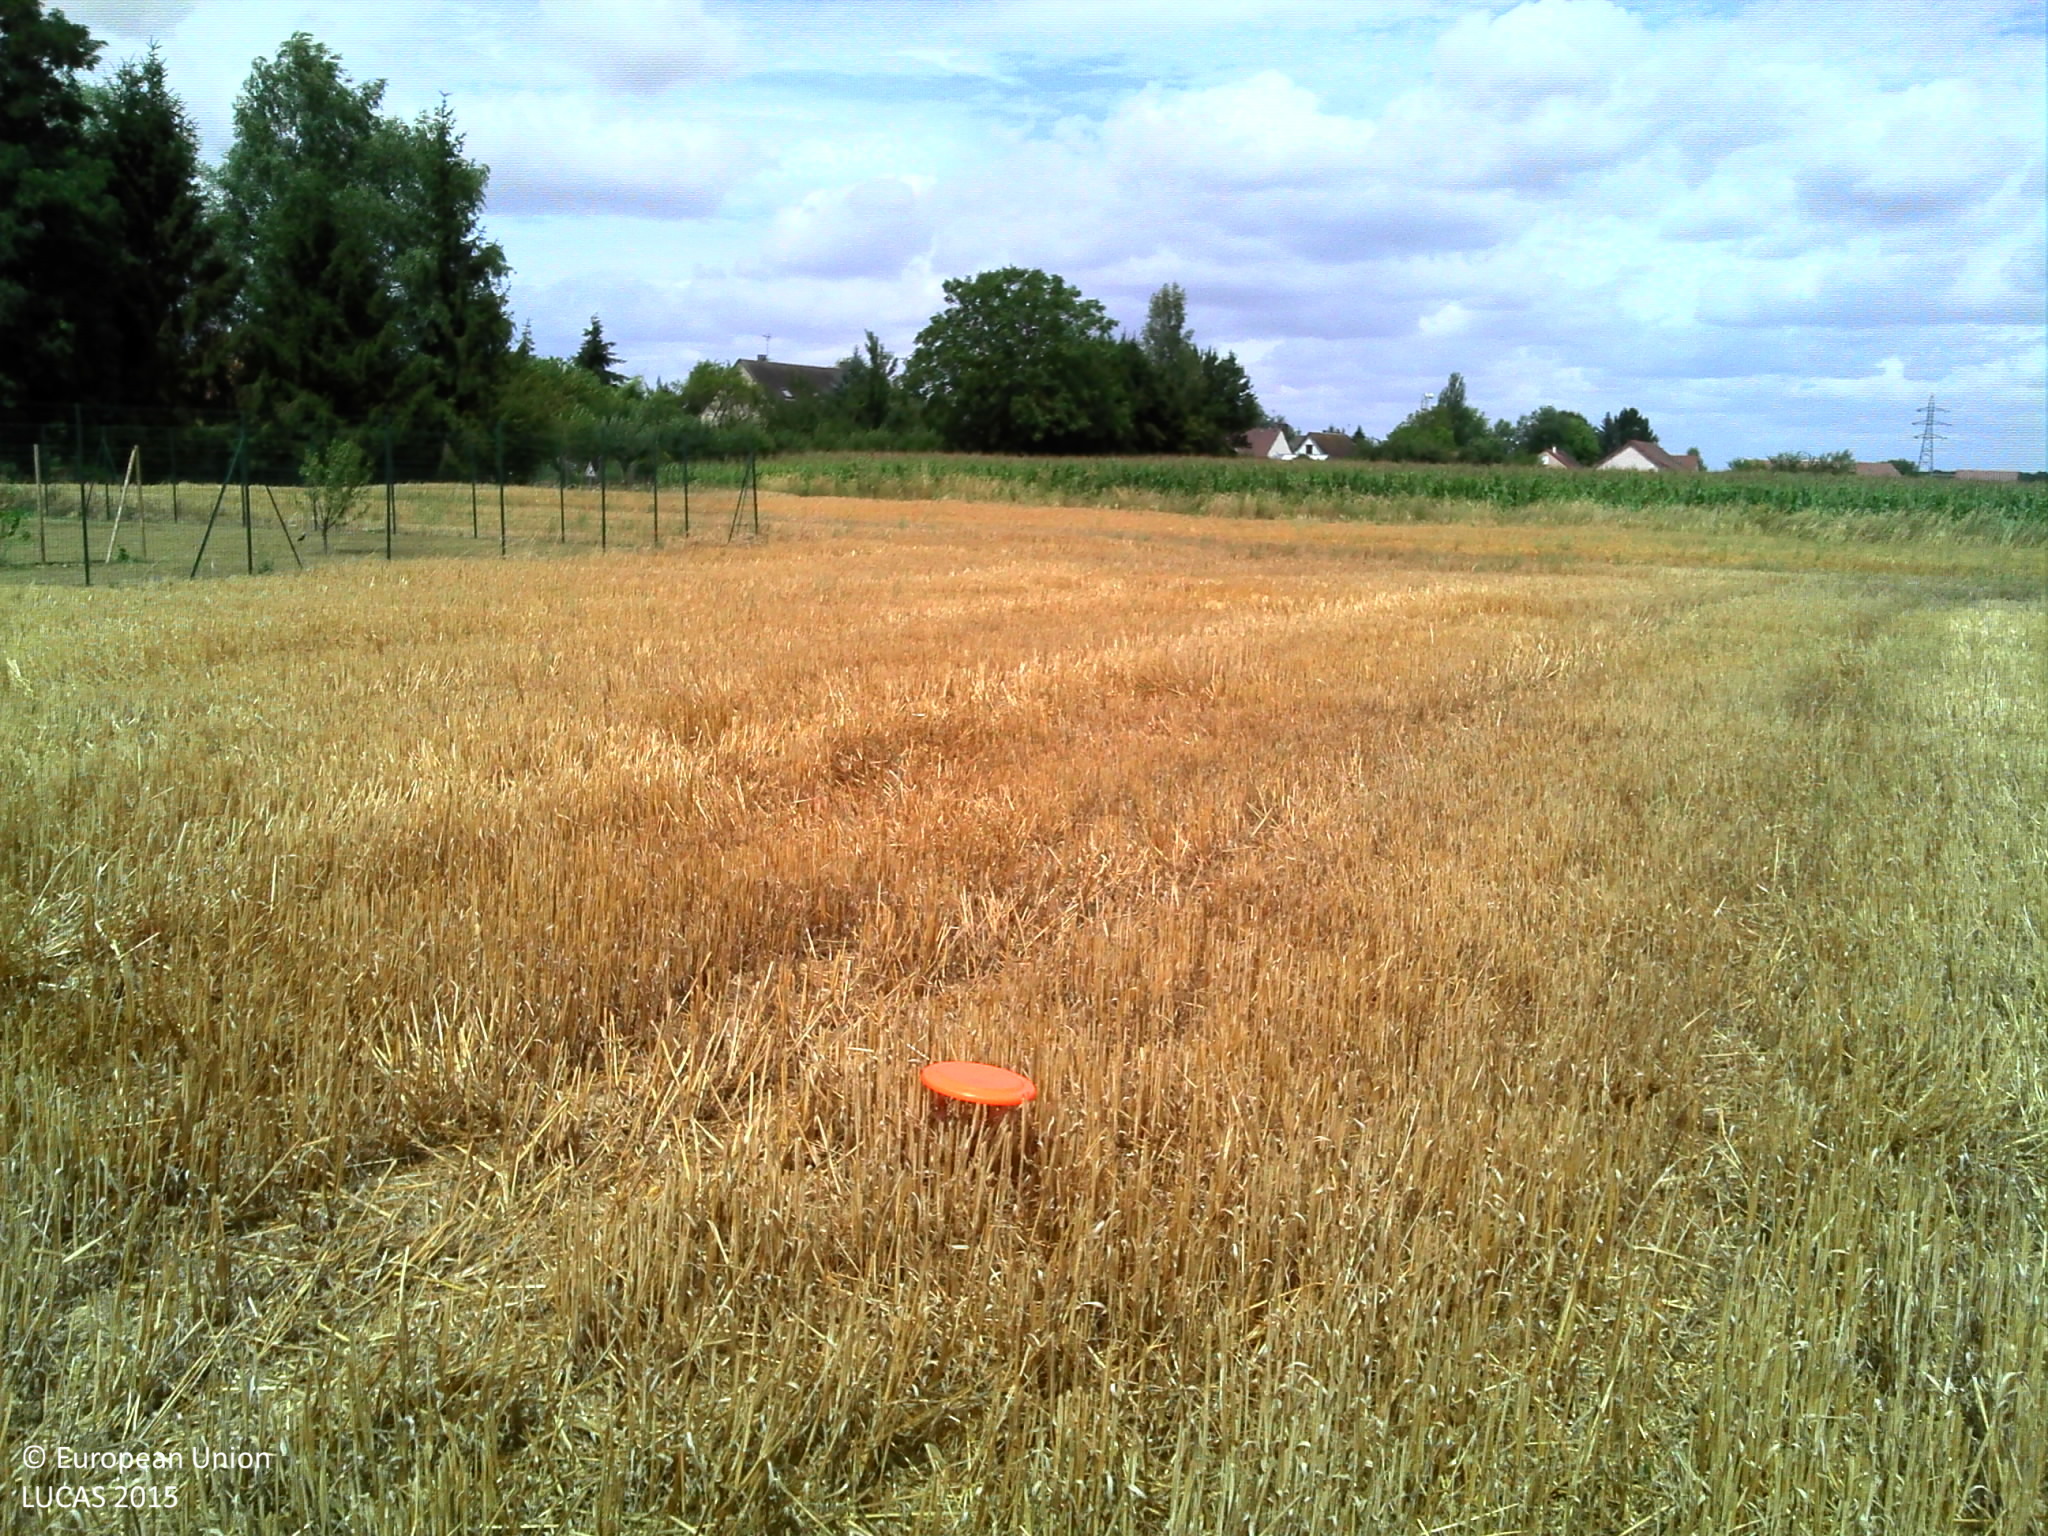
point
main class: Cropland
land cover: Barley
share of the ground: > 75 %
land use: Agriculture (excluding fallow land and kitchen gardens)
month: July
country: FR
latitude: 47.8813
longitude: 3.1071
